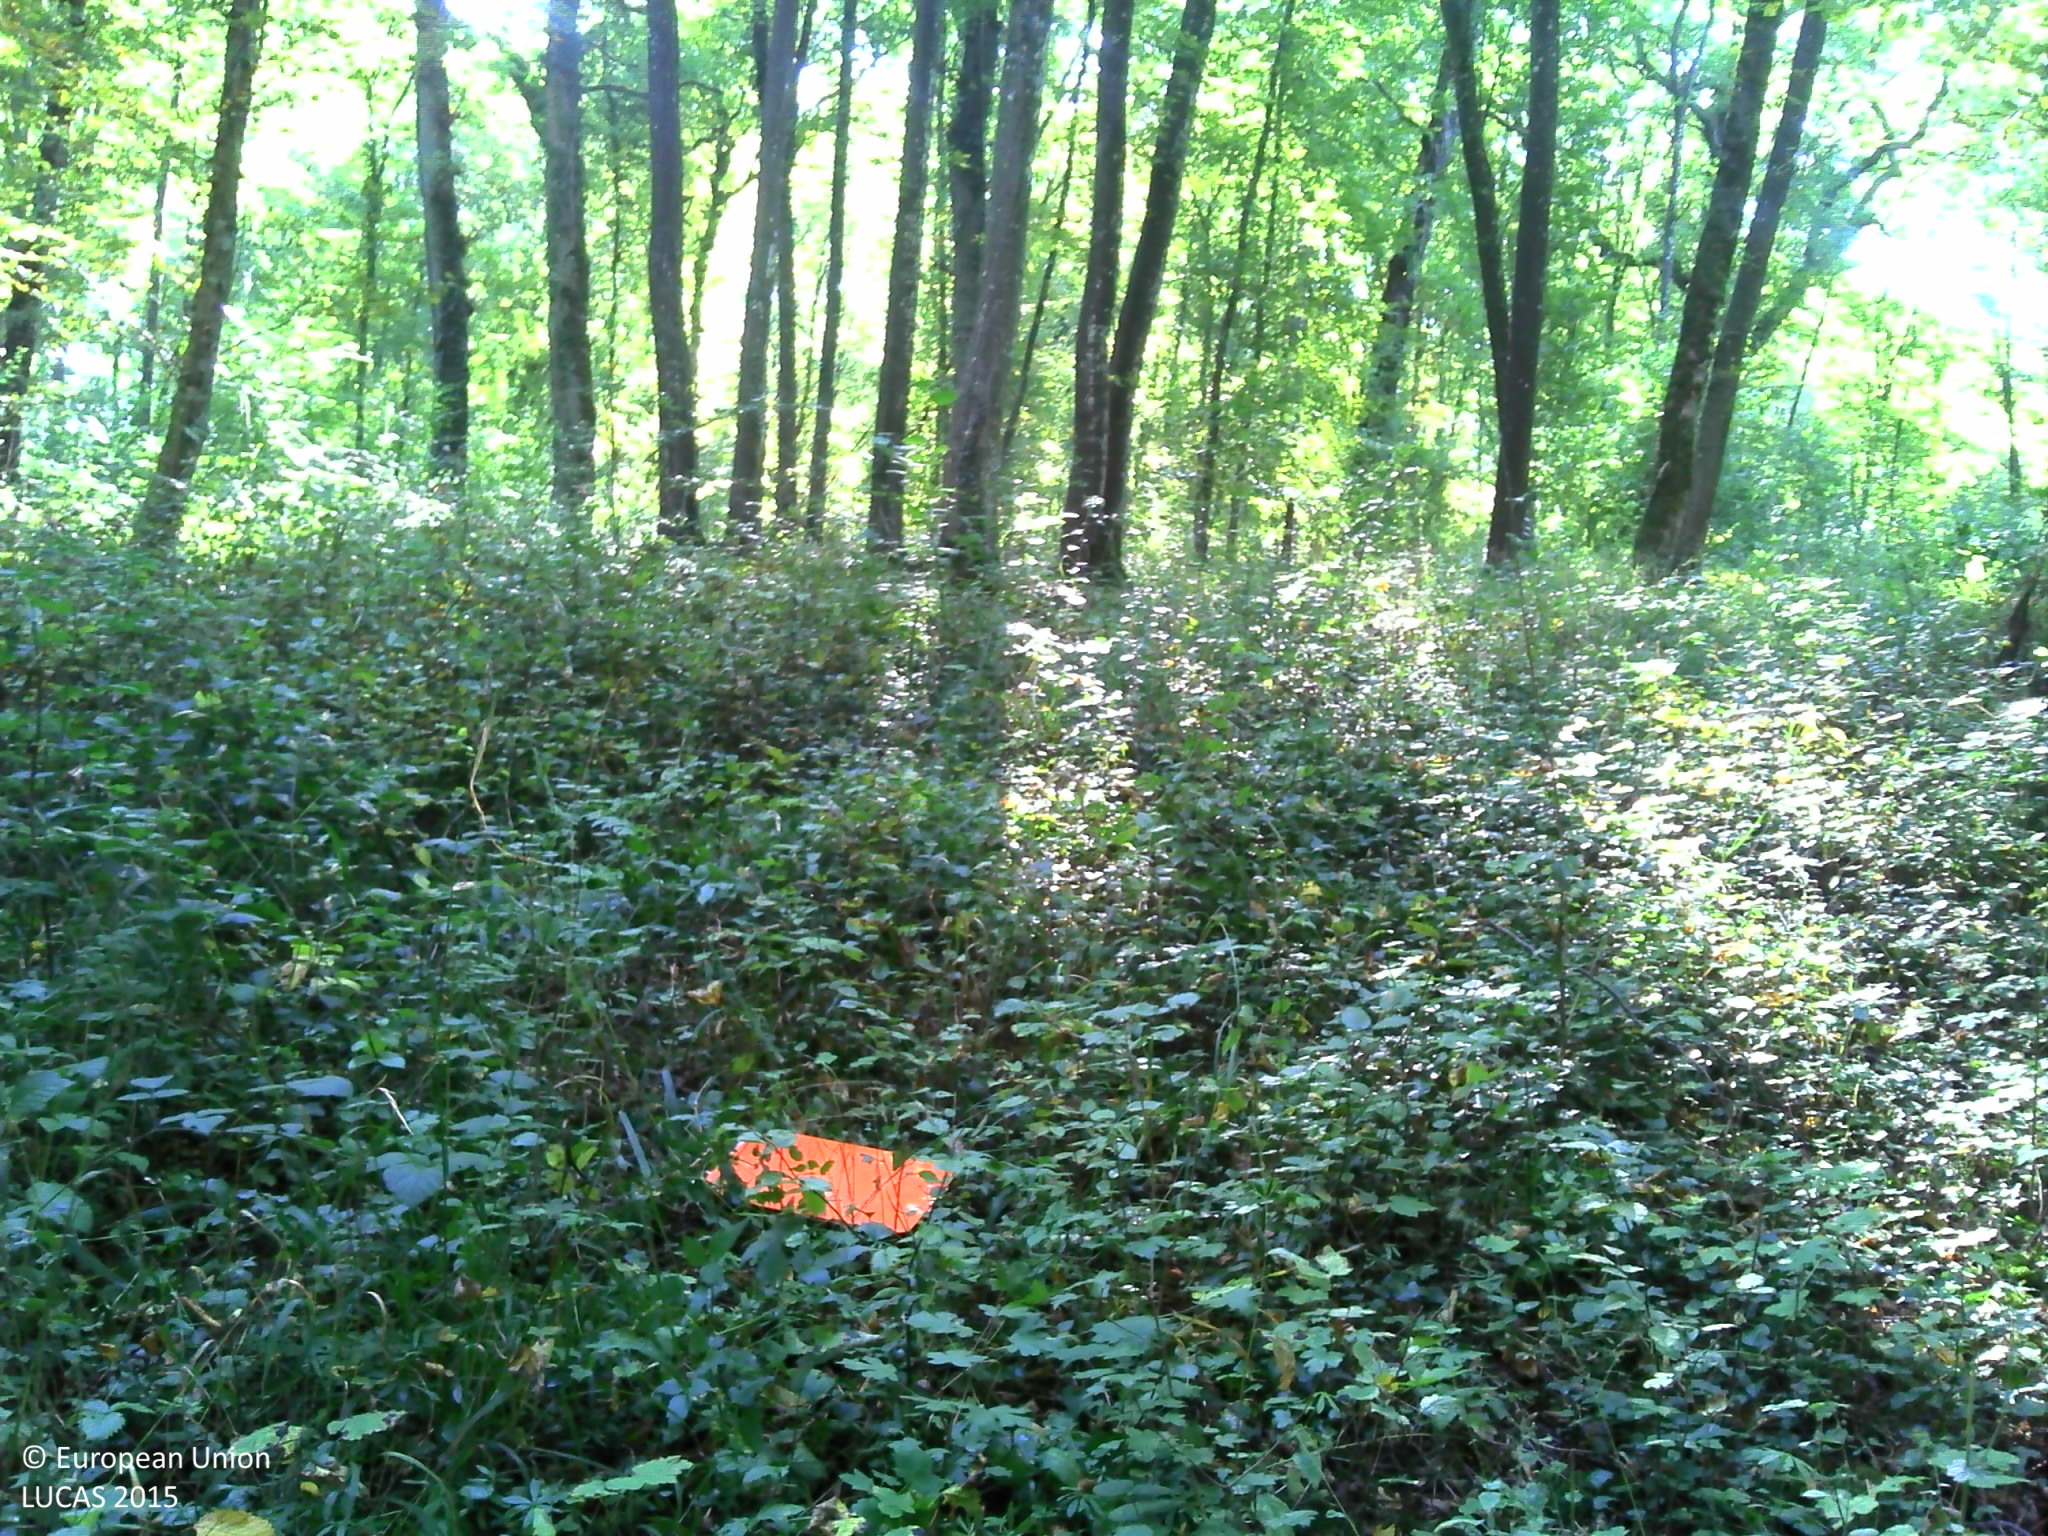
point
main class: Woodland
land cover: Broadleaved woodland
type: mesophytic deciduous forest
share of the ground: > 75 %
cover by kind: broadleaved forest trees 90 %, herbaceous plants 5 %, consolidated bare surface 5 %
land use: Forestry
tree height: > 5 m
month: September
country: FR
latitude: 49.2838
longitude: 5.9439
